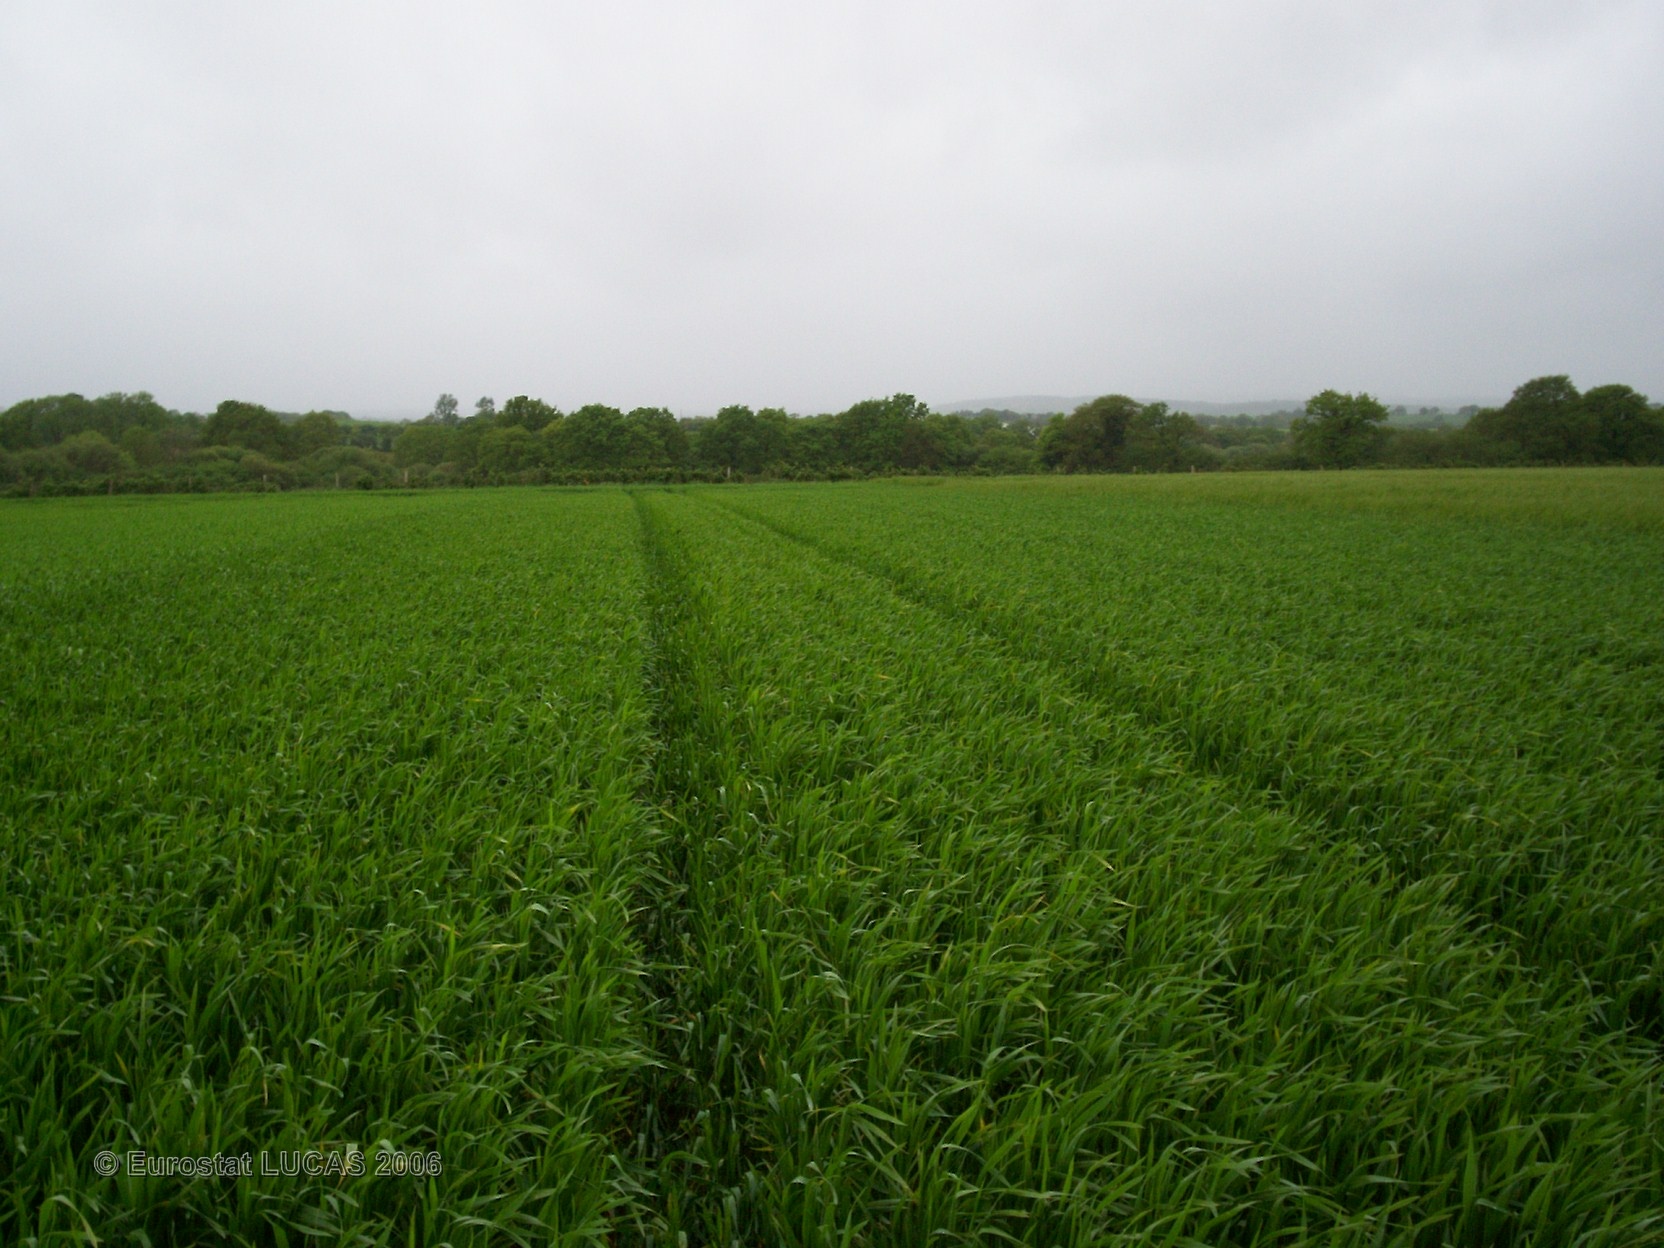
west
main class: Cropland
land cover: Common wheat
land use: Agriculture (excluding fallow land and kitchen gardens)
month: May
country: FR
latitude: 48.3203
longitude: -3.6343
